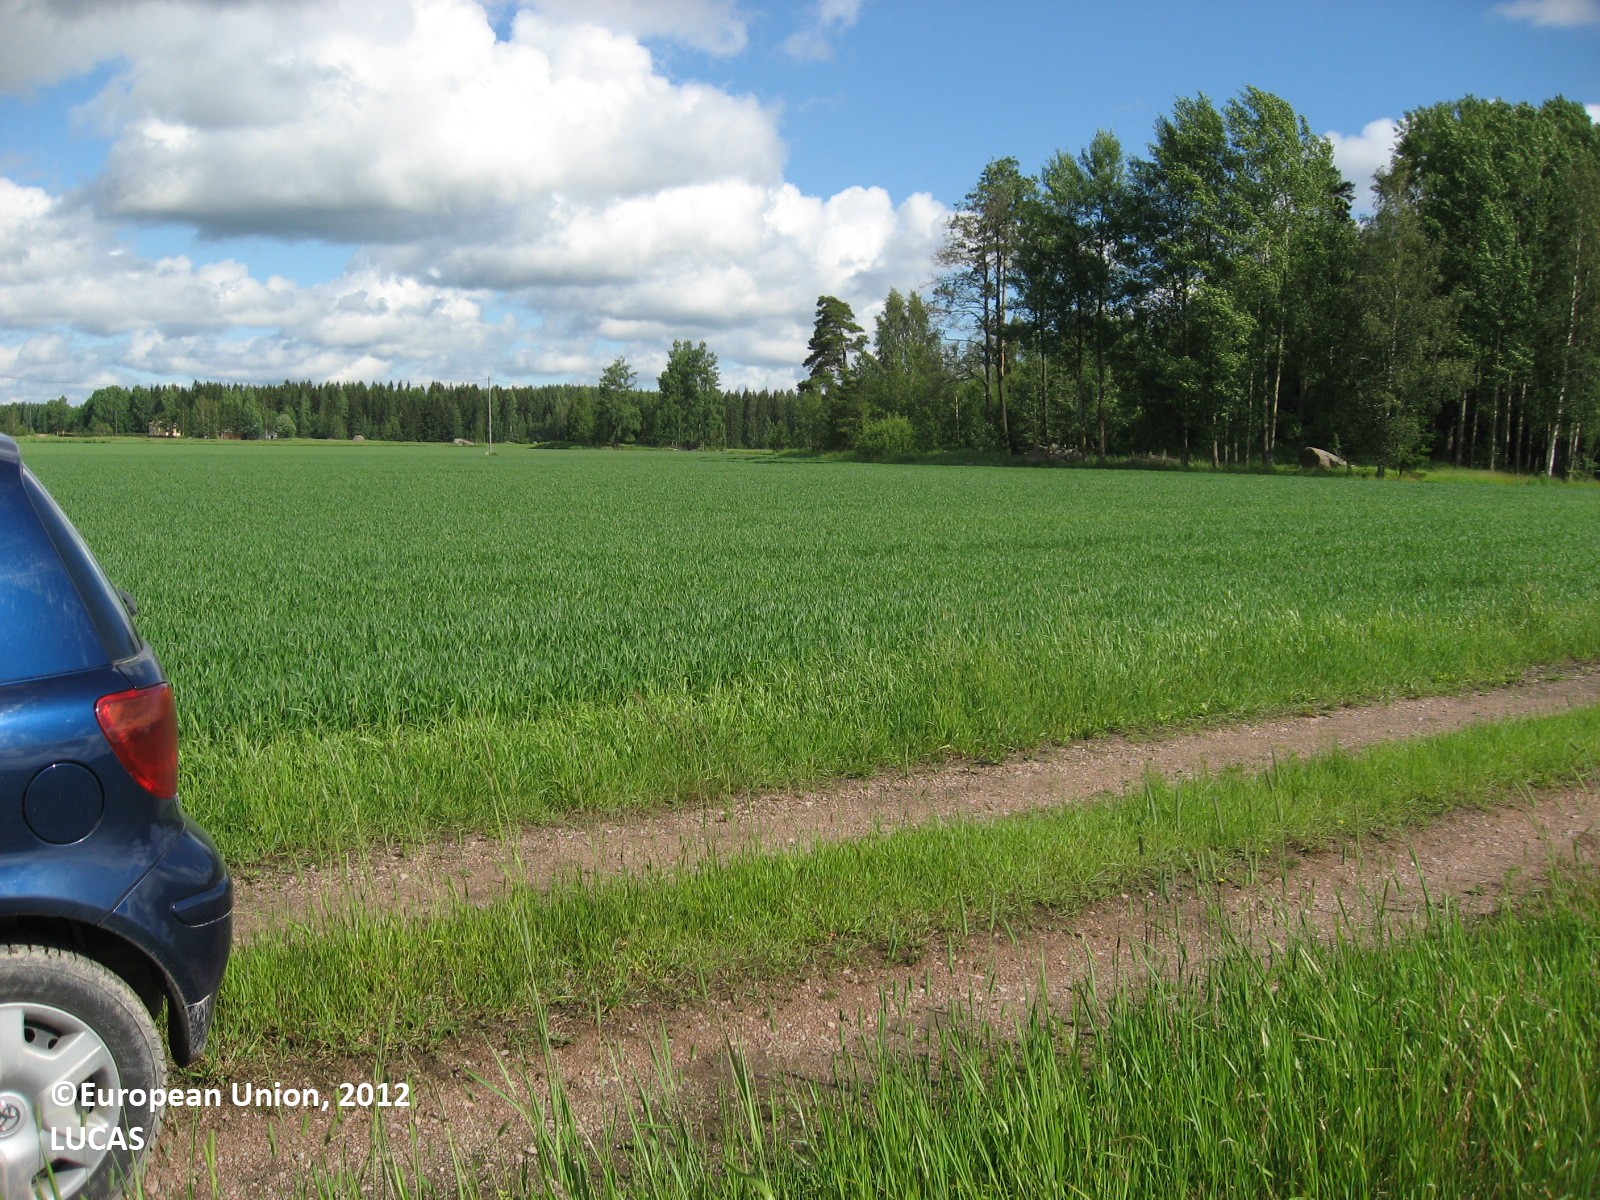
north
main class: Cropland
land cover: Barley
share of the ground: 50 - 75 %
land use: Agriculture (excluding fallow land and kitchen gardens)
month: June
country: FI
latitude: 60.5789
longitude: 26.3760
